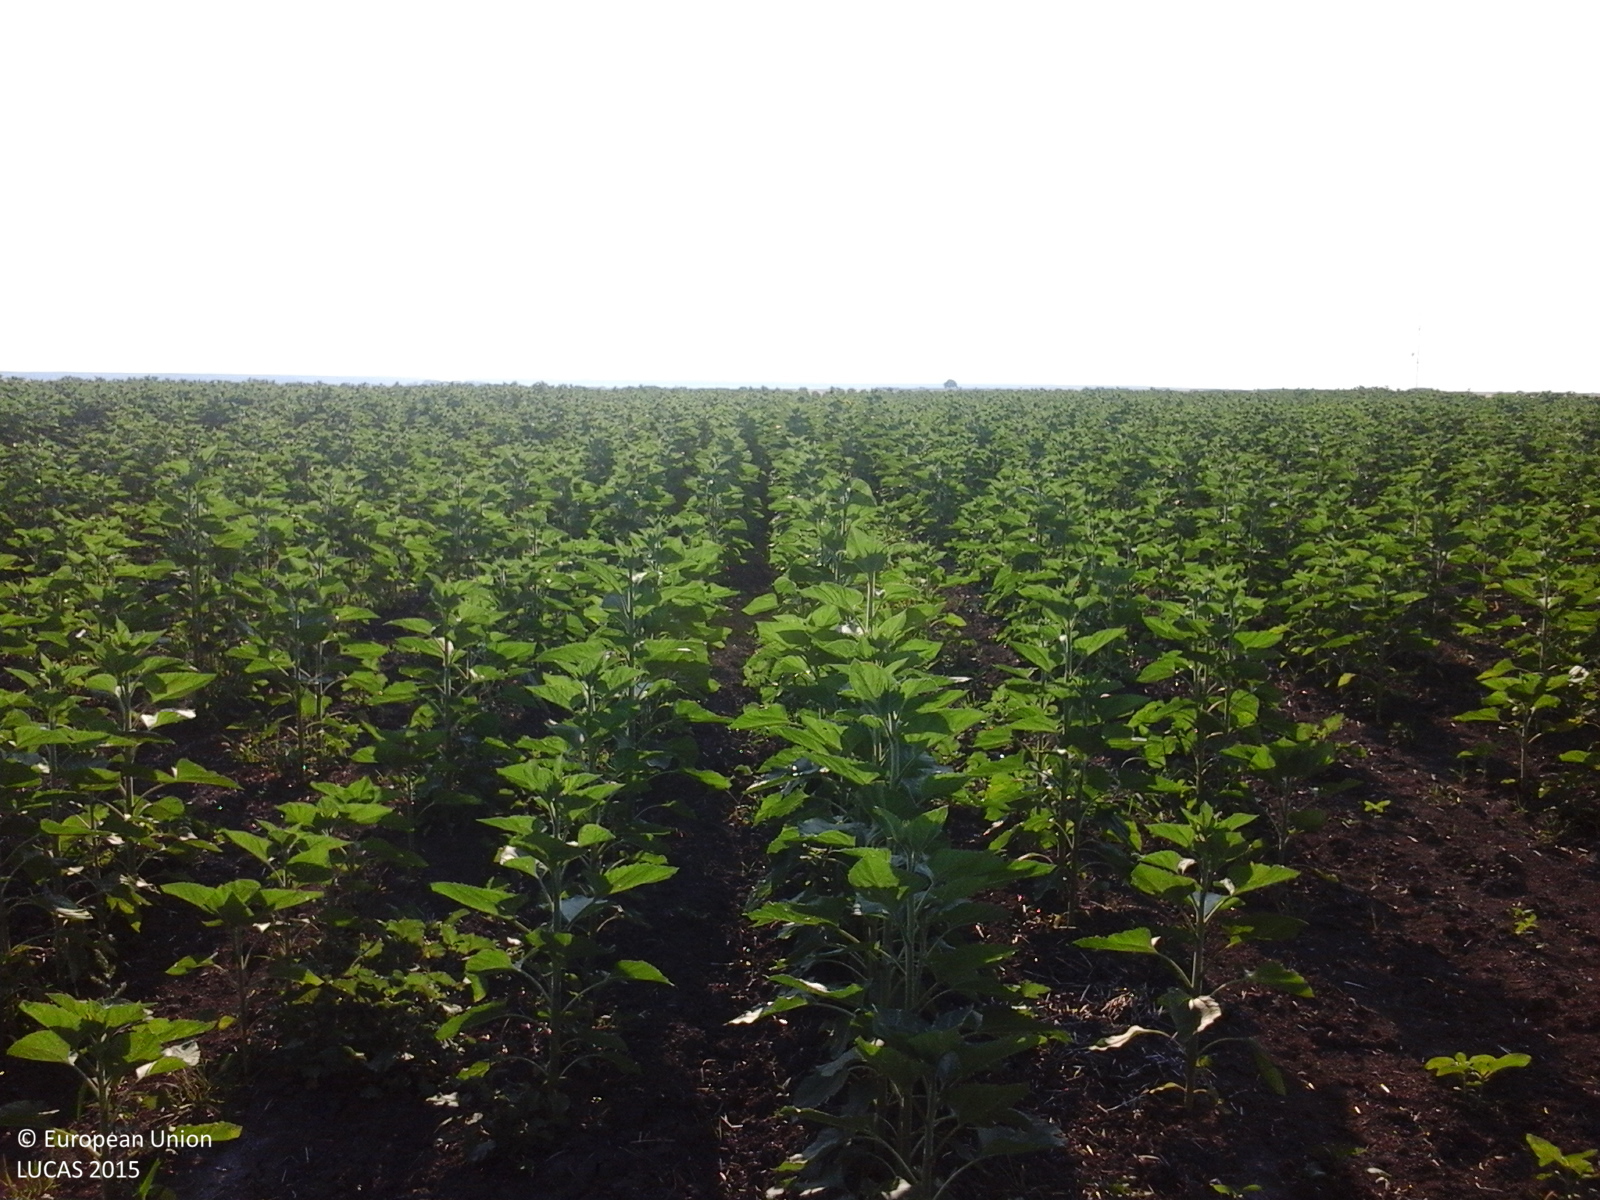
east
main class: Cropland
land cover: Sunflower
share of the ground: 50 - 75 %
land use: Agriculture (excluding fallow land and kitchen gardens)
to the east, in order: Sunflower; Inland fresh water bodies
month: July
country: RO
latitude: 44.5718
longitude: 24.7467
